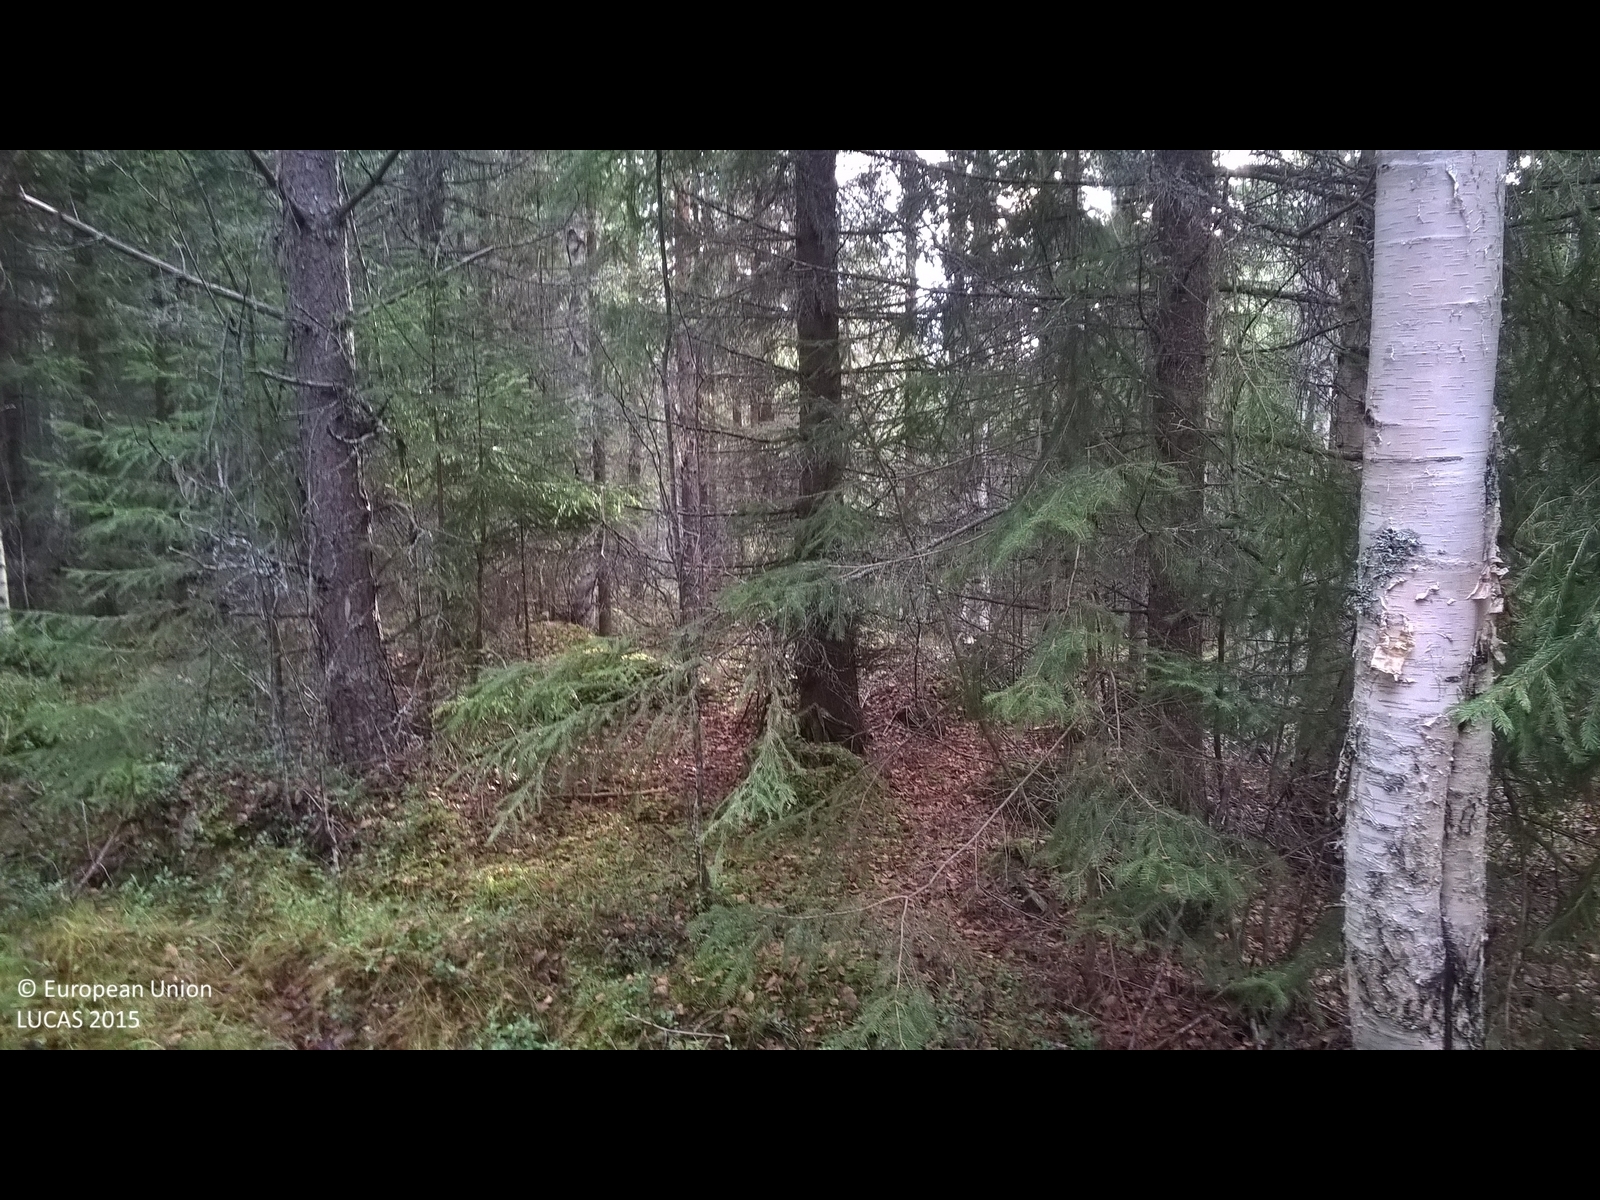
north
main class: Woodland
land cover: Spruce dominated mixed woodland
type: boreal forest
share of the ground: > 75 %
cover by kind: coniferous forest trees 60 %, broadleaved forest trees 30 %, herbaceous plants 5 %, lichens and mosses 5 %
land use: Forestry
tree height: > 5 m
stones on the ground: < 10 %
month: November
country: SE
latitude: 62.8871
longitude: 15.6225
